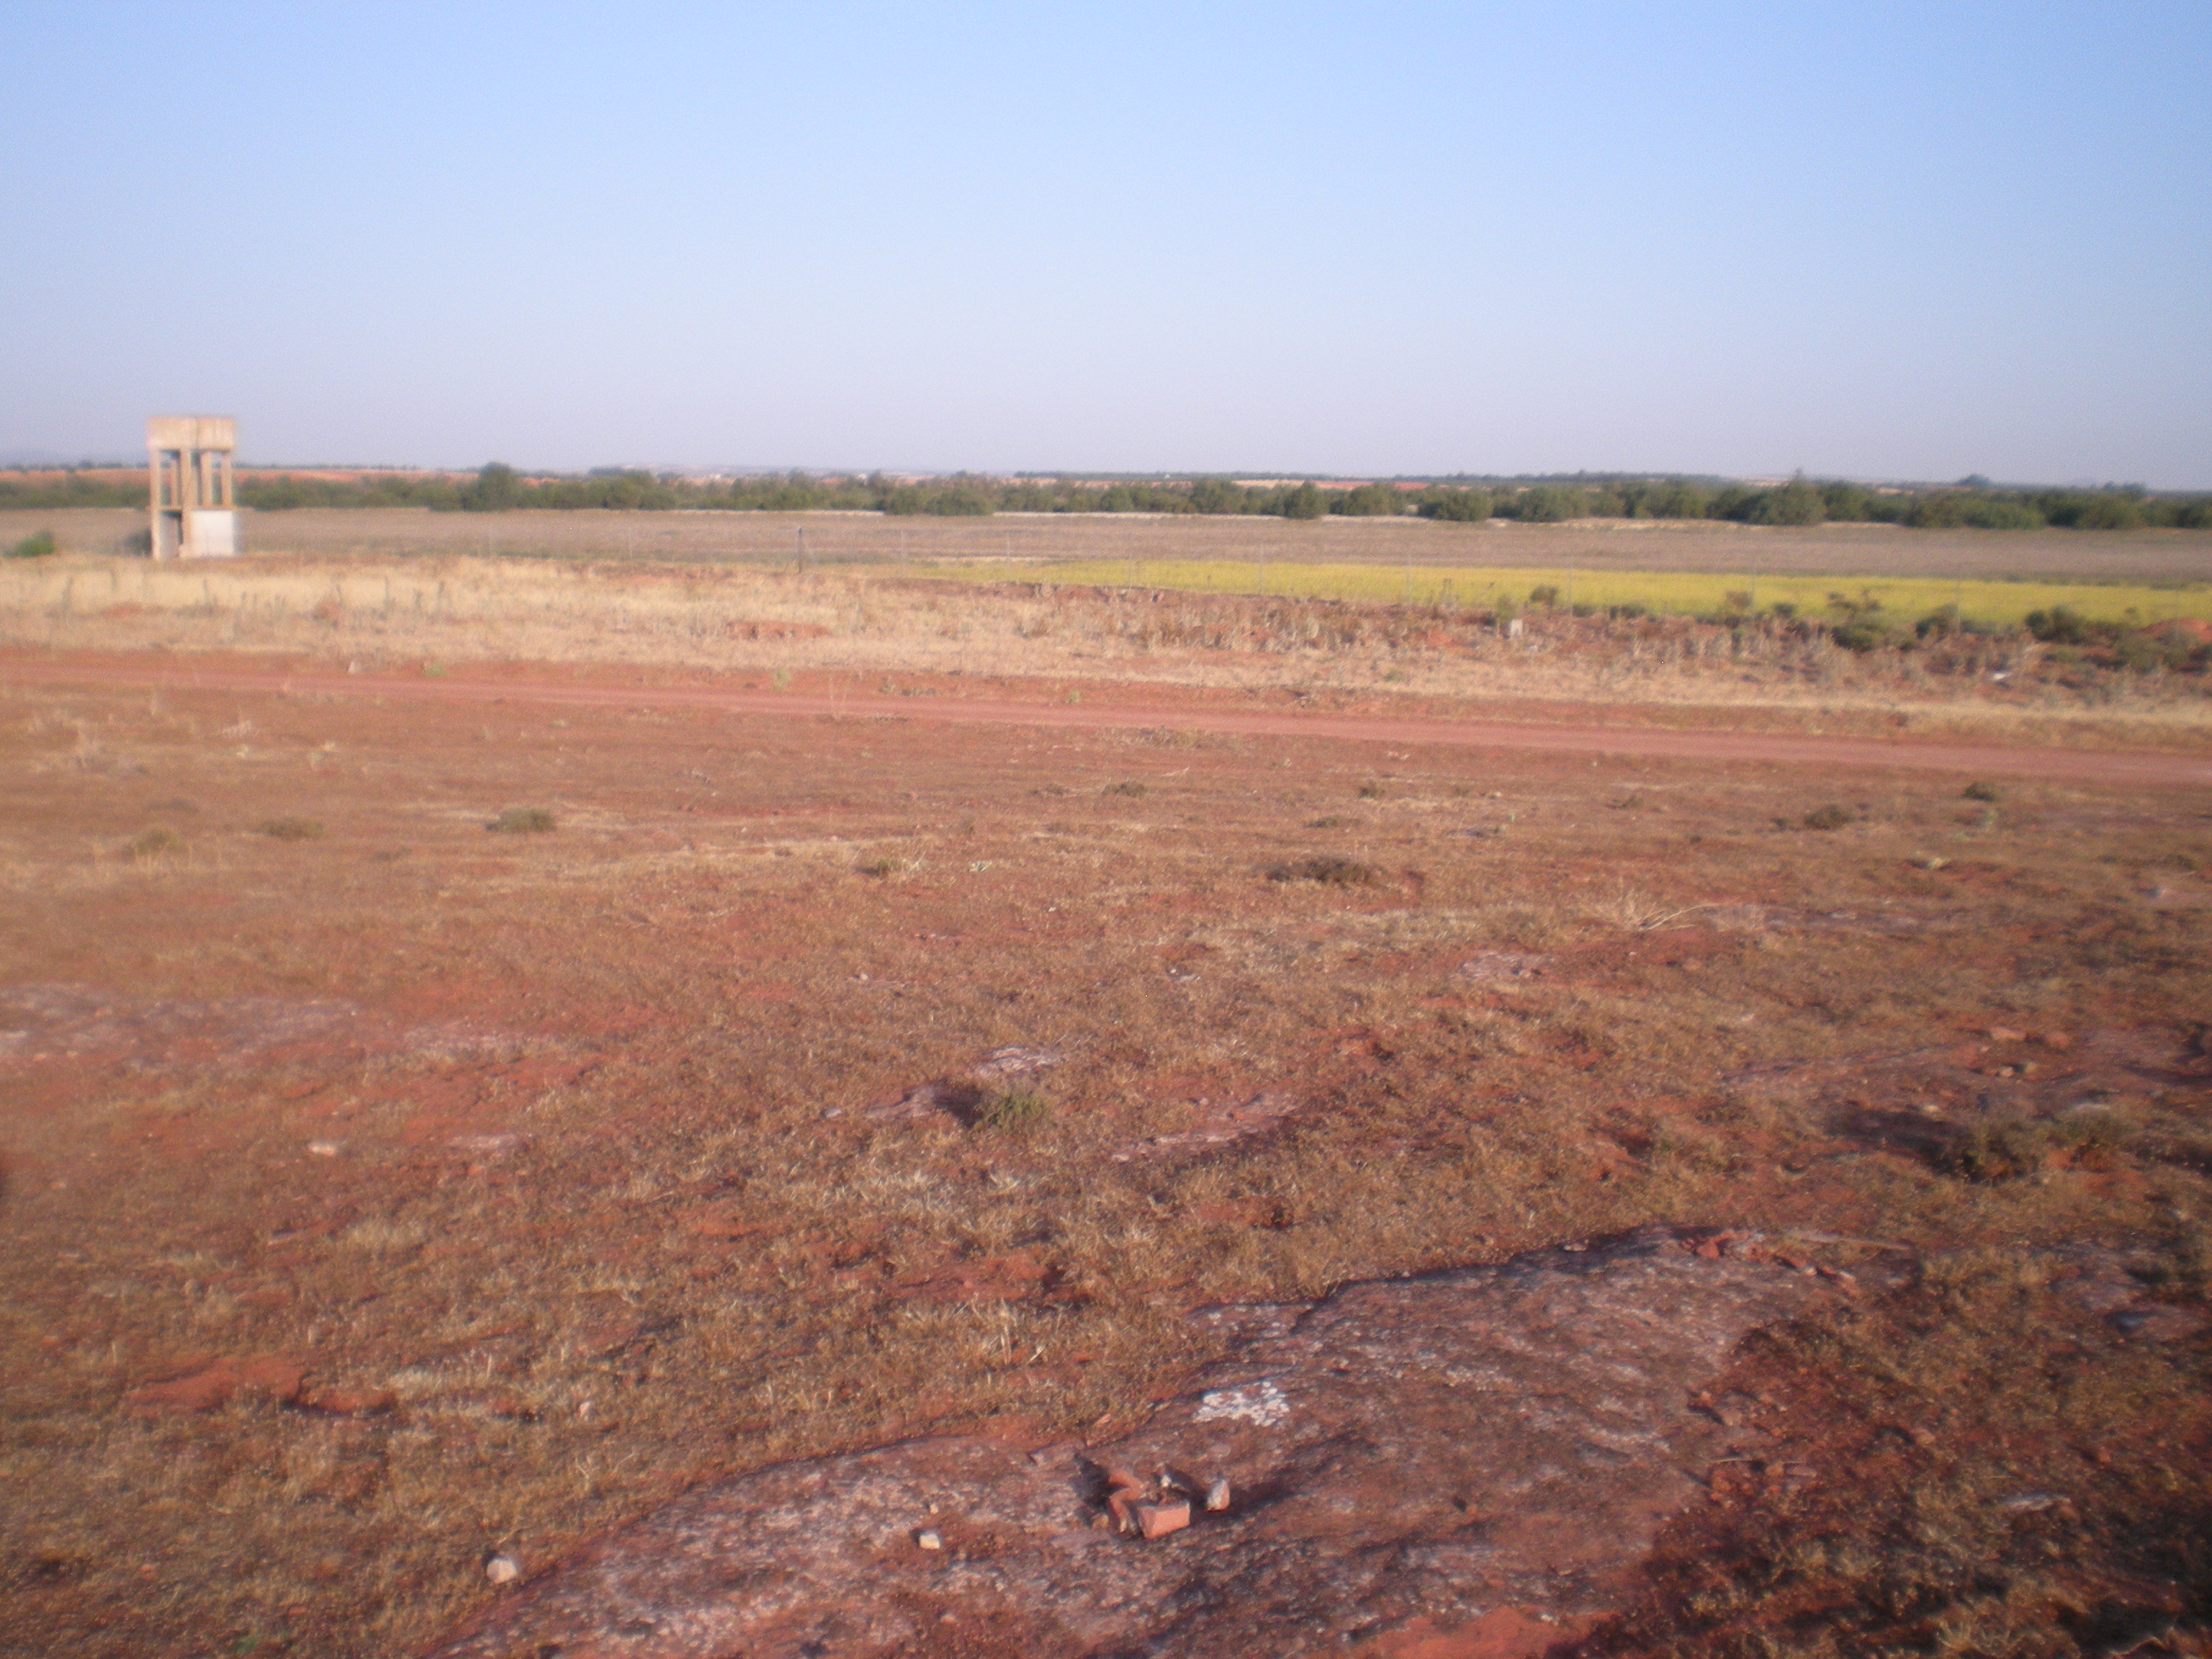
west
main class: Grassland
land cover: Grassland without tree/shrub cover
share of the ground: 25 - 50 %
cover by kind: unconsolidated bare surface 70 %, herbaceous plants 30 %
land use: Agriculture (excluding fallow land and kitchen gardens)
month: July
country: ES
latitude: 39.4487
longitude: -3.3018
